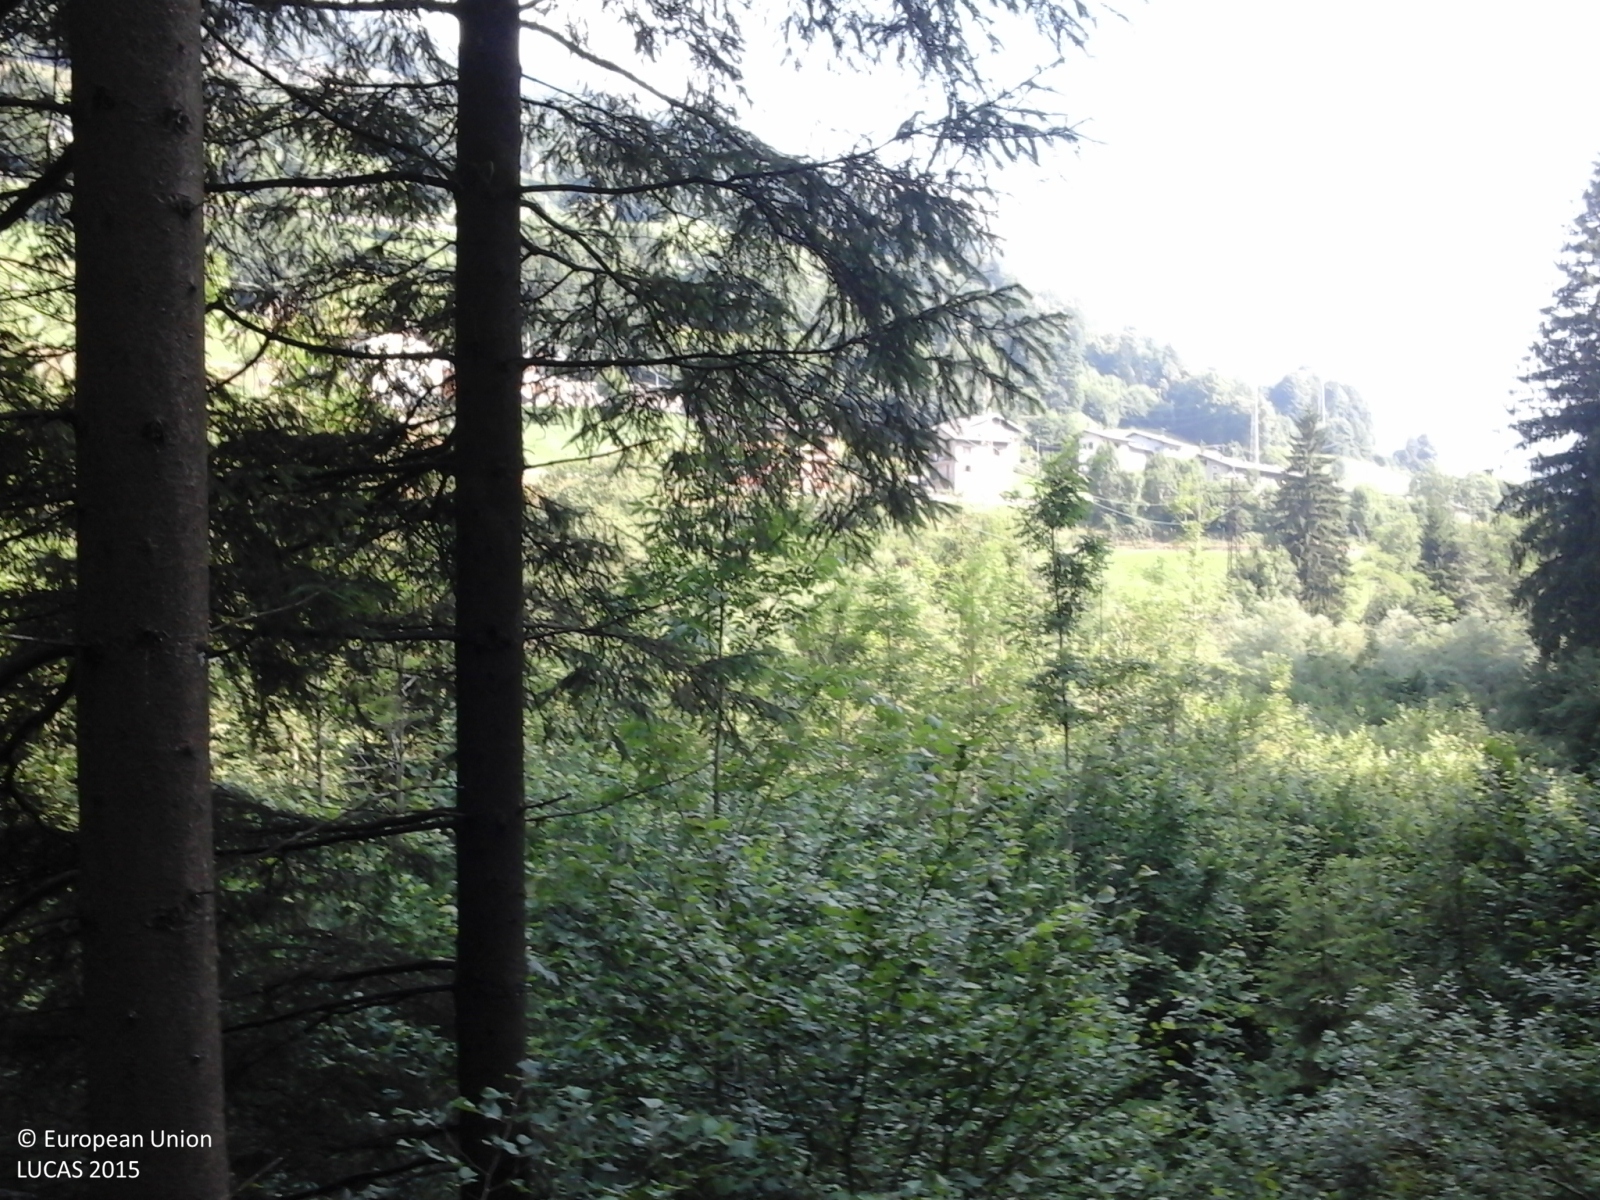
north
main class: Woodland
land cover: Spruce dominated coniferous woodland
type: alpine coniferous forest
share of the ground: > 75 %
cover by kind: coniferous forest trees 80 %, broadleaved forest trees 20 %
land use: Semi-natural and natural areas not in use
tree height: > 5 m
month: July
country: IT
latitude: 45.9729
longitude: 9.9356
